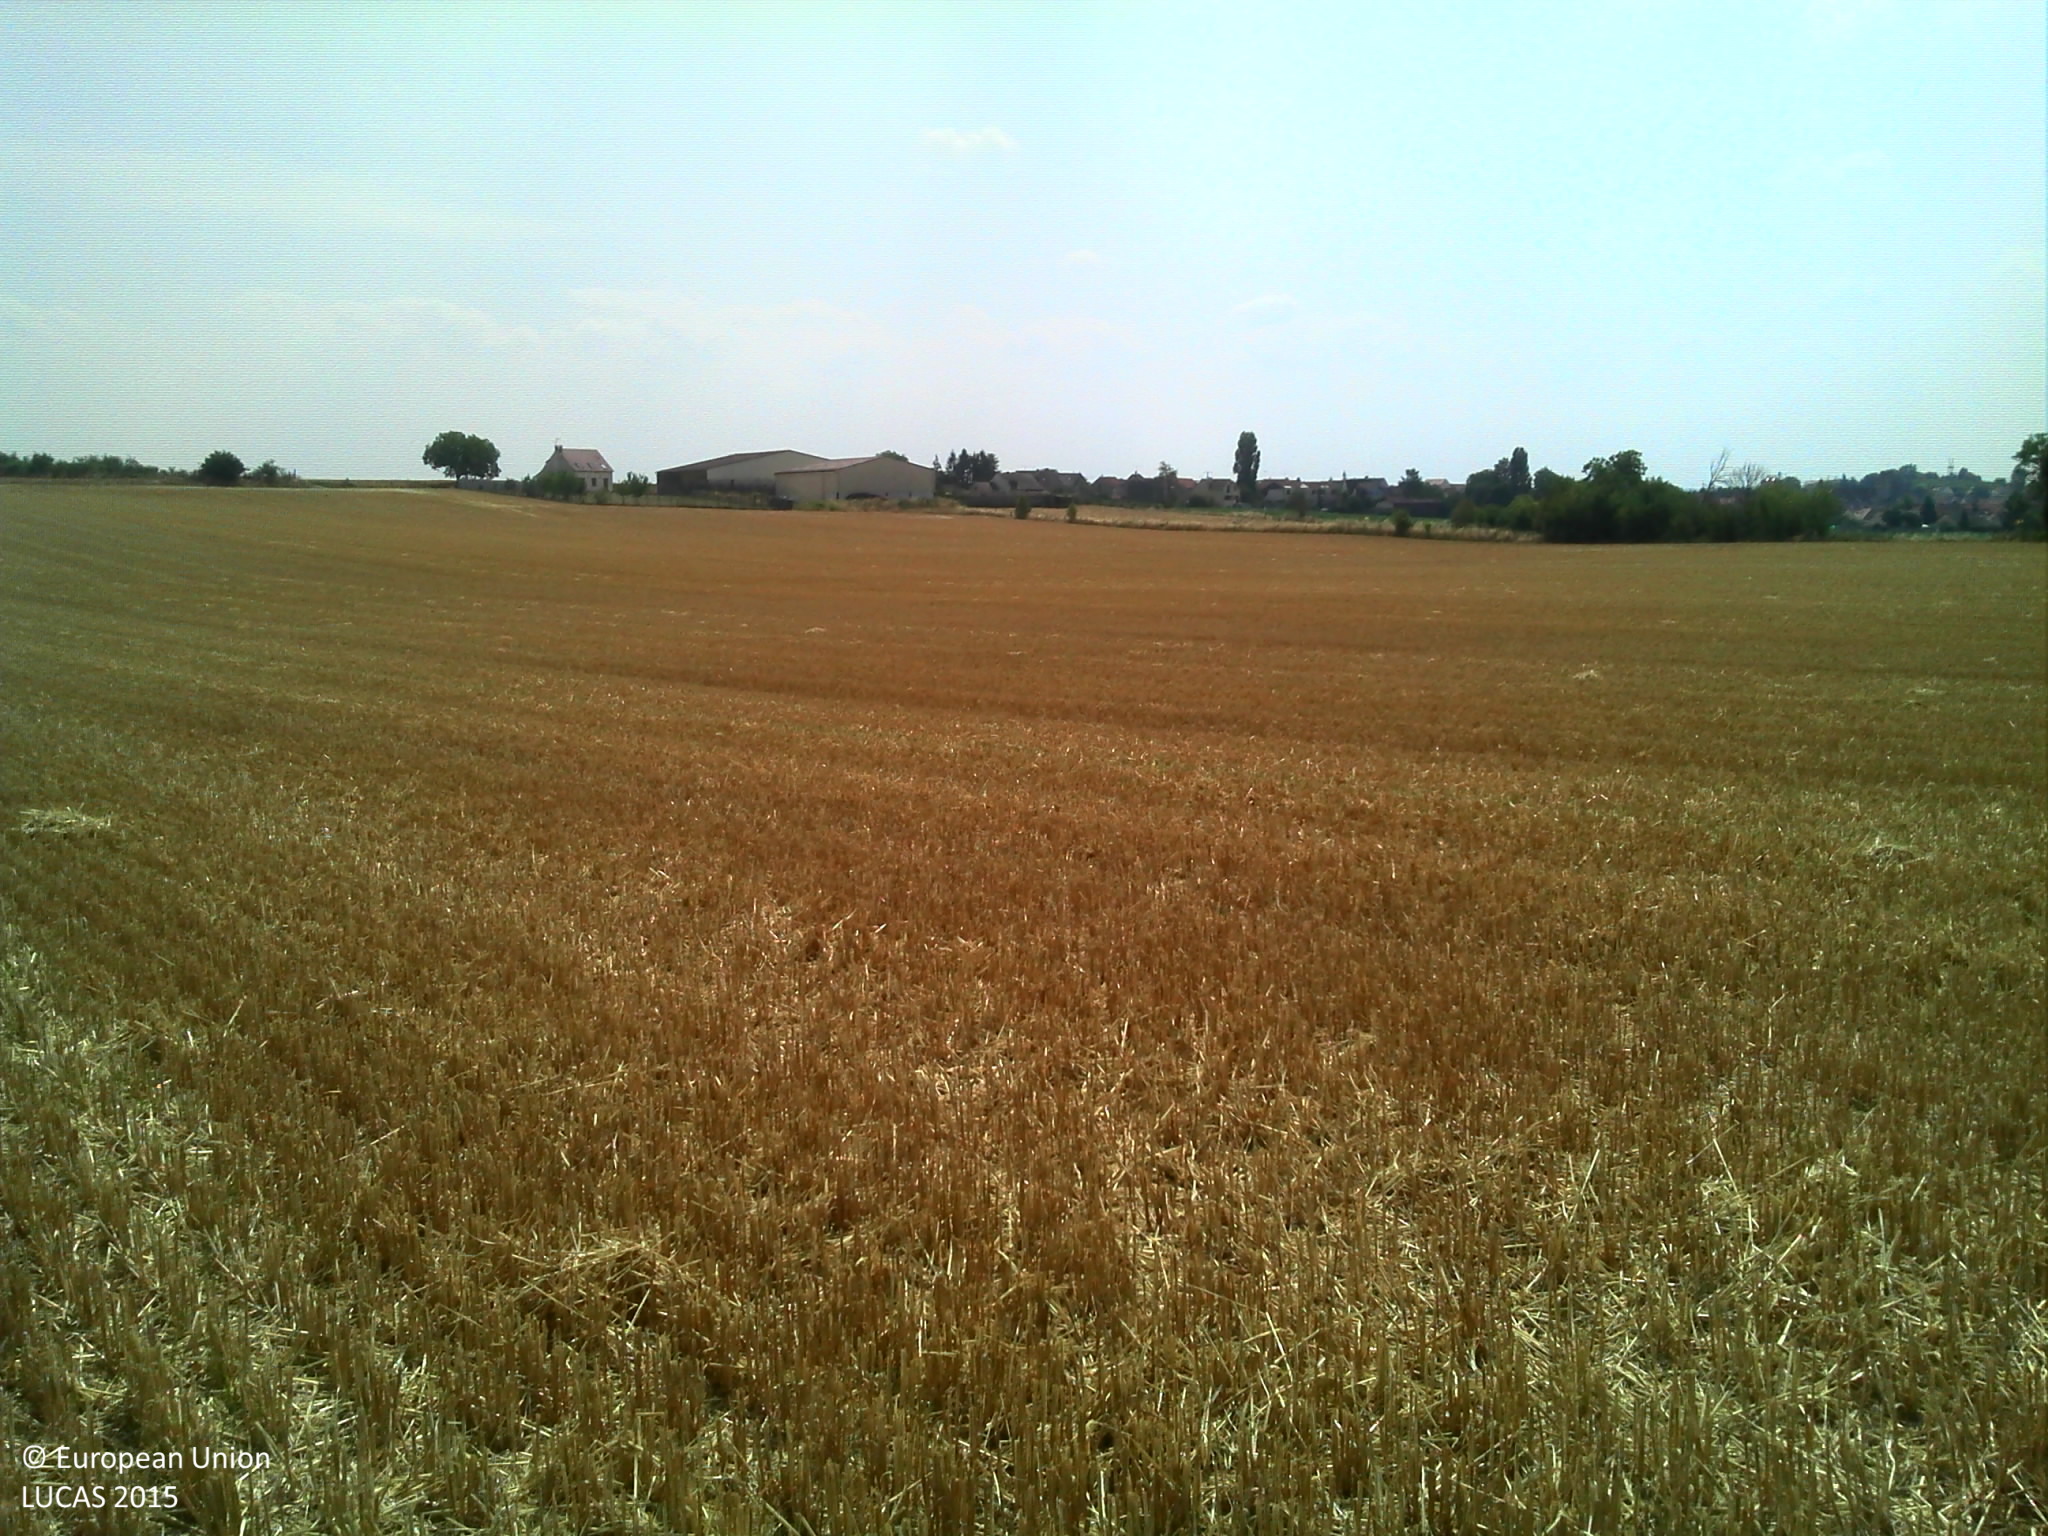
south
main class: Cropland
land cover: Triticale
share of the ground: > 75 %
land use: Agriculture (excluding fallow land and kitchen gardens)
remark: Harvested field
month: August
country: FR
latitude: 49.0056
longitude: 2.8957
